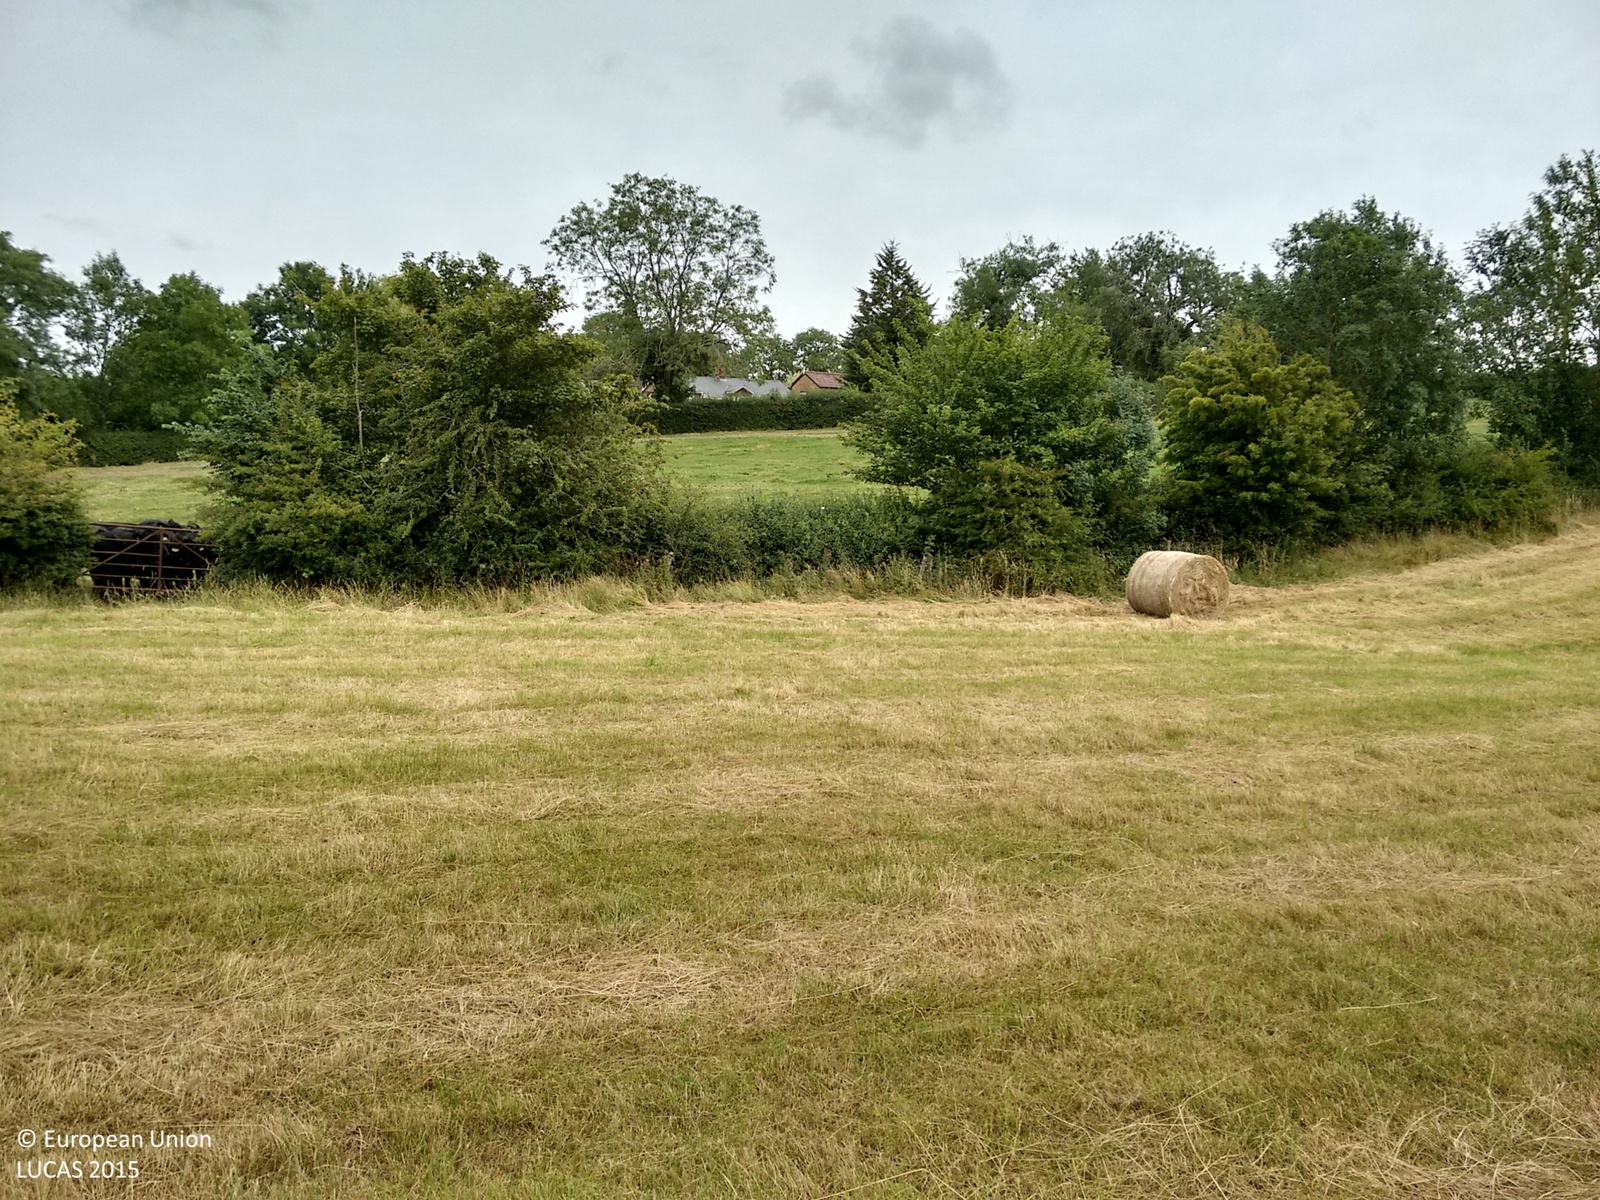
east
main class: Grassland
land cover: Grassland without tree/shrub cover
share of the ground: > 75 %
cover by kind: herbaceous plants 100 %
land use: Agriculture (excluding fallow land and kitchen gardens)
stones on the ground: < 10 %
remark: Harvested field
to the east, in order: Grassland without tree/shrub cover; Managed hedges; Grassland without tree/shrub cover; Managed hedges; Grass margins; Artificial constructions in urban areas; Grassland without tree/shrub cover; Abandoned hedges; Common wheat
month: August
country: GB
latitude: 52.1011
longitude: -1.1857
